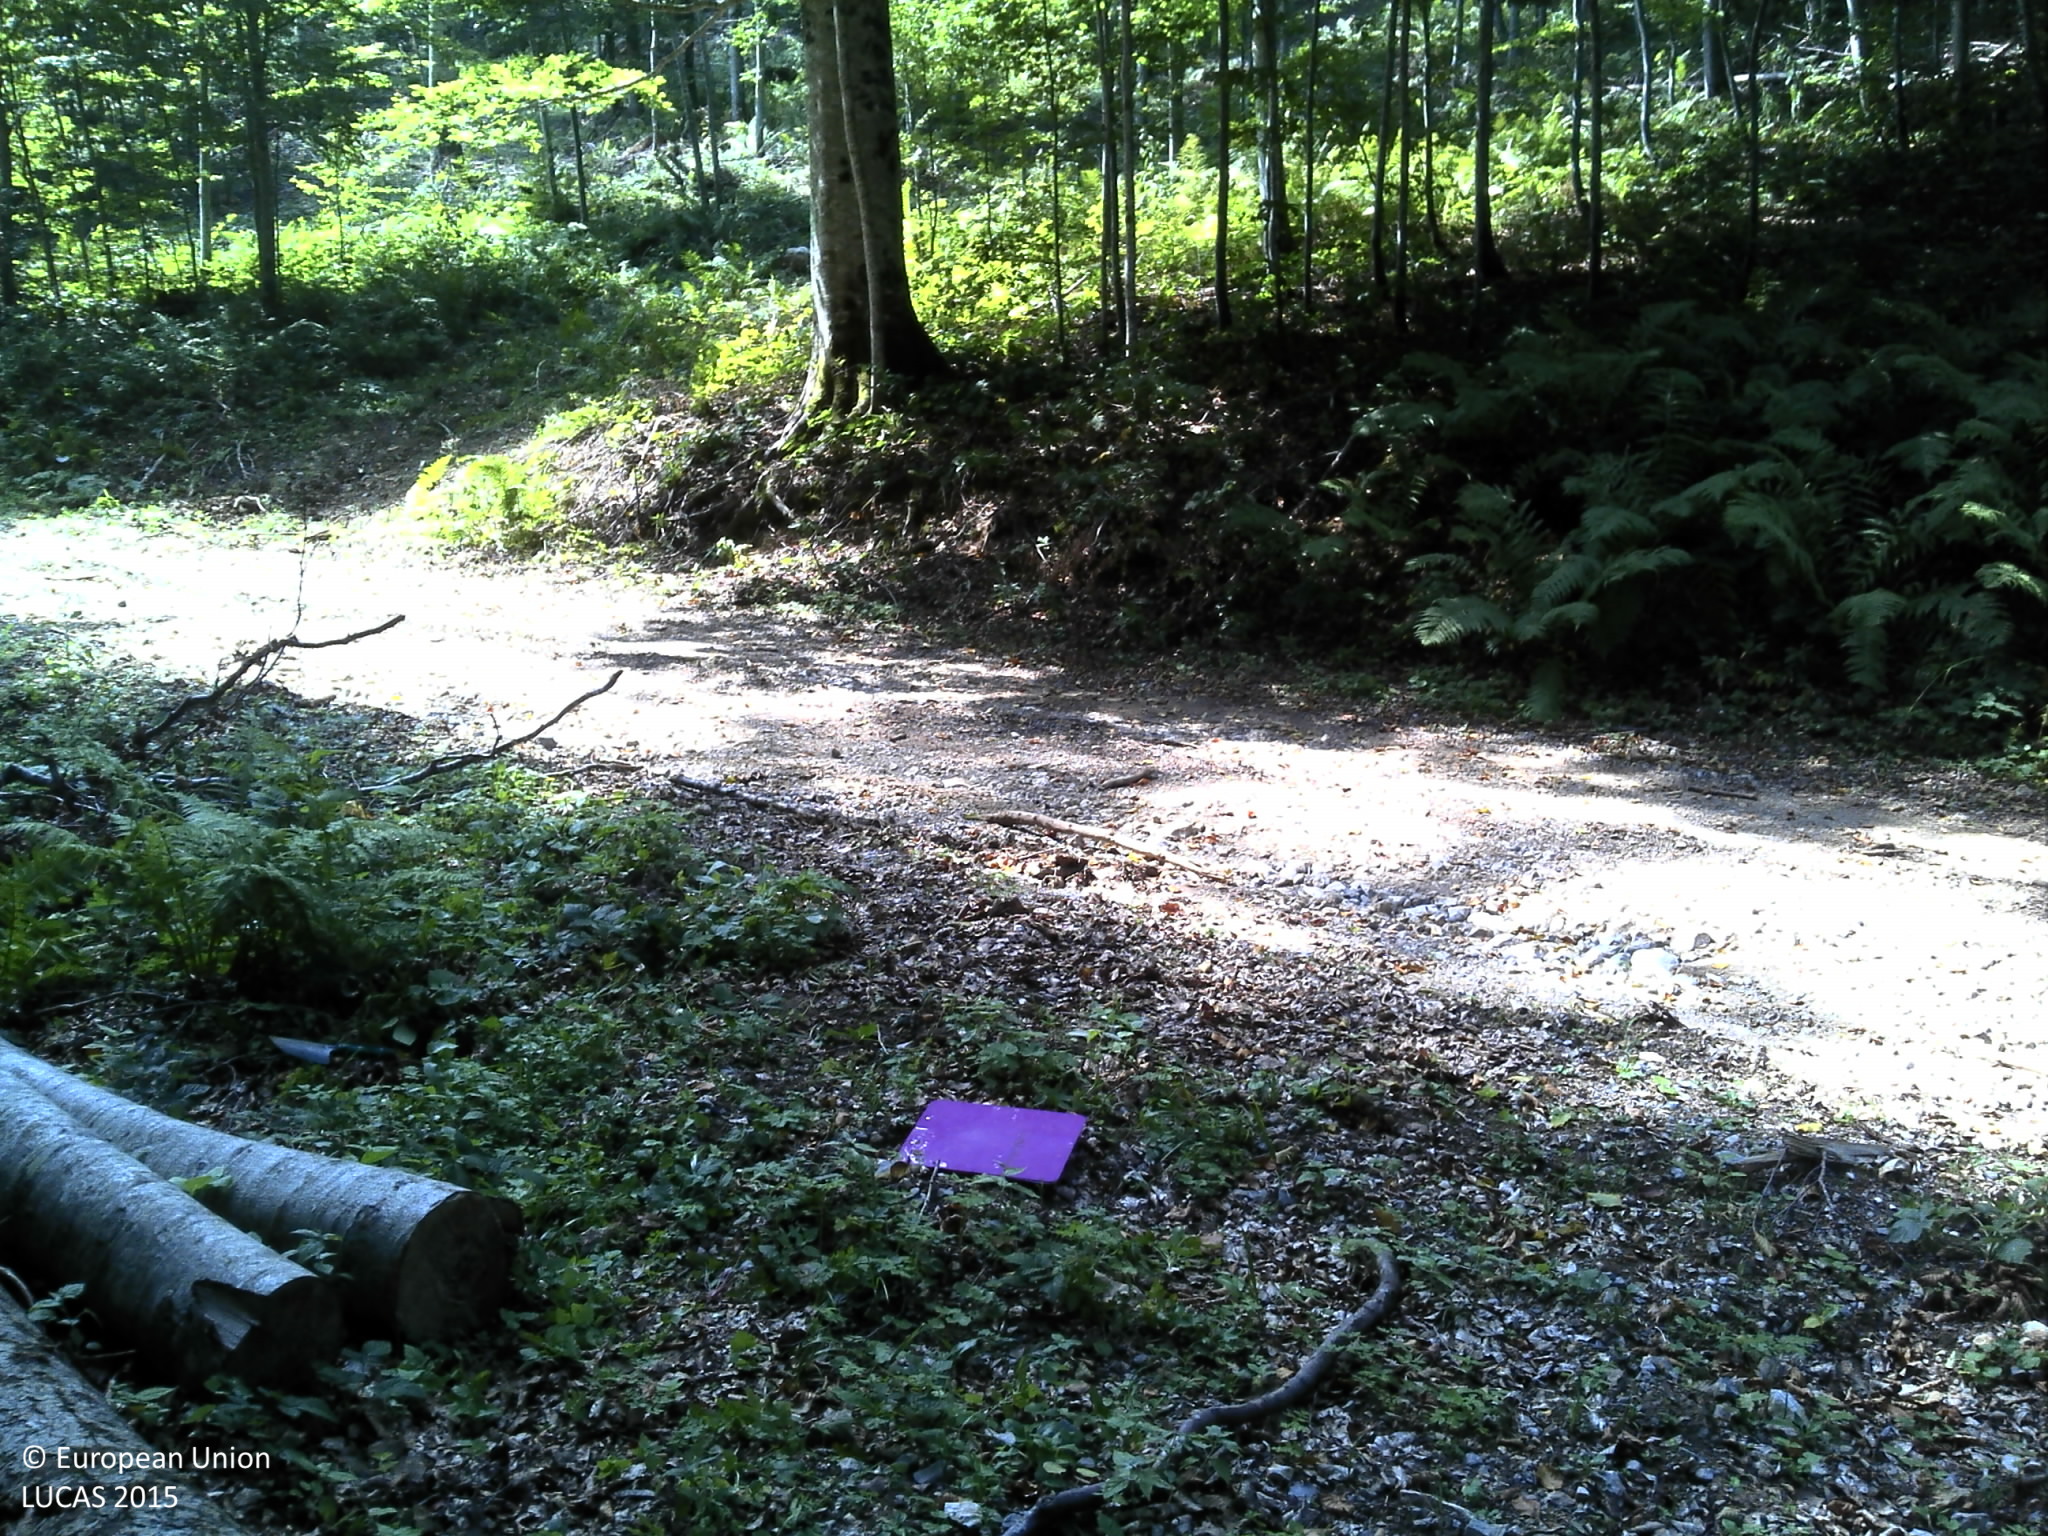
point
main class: Woodland
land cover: Broadleaved woodland
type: mountainous beech forest
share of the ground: > 75 %
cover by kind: broadleaved forest trees 95 %, coniferous forest trees 5 %
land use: Forestry
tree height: > 5 m
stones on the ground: < 10 %
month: September
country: HR
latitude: 44.4725
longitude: 15.8895
